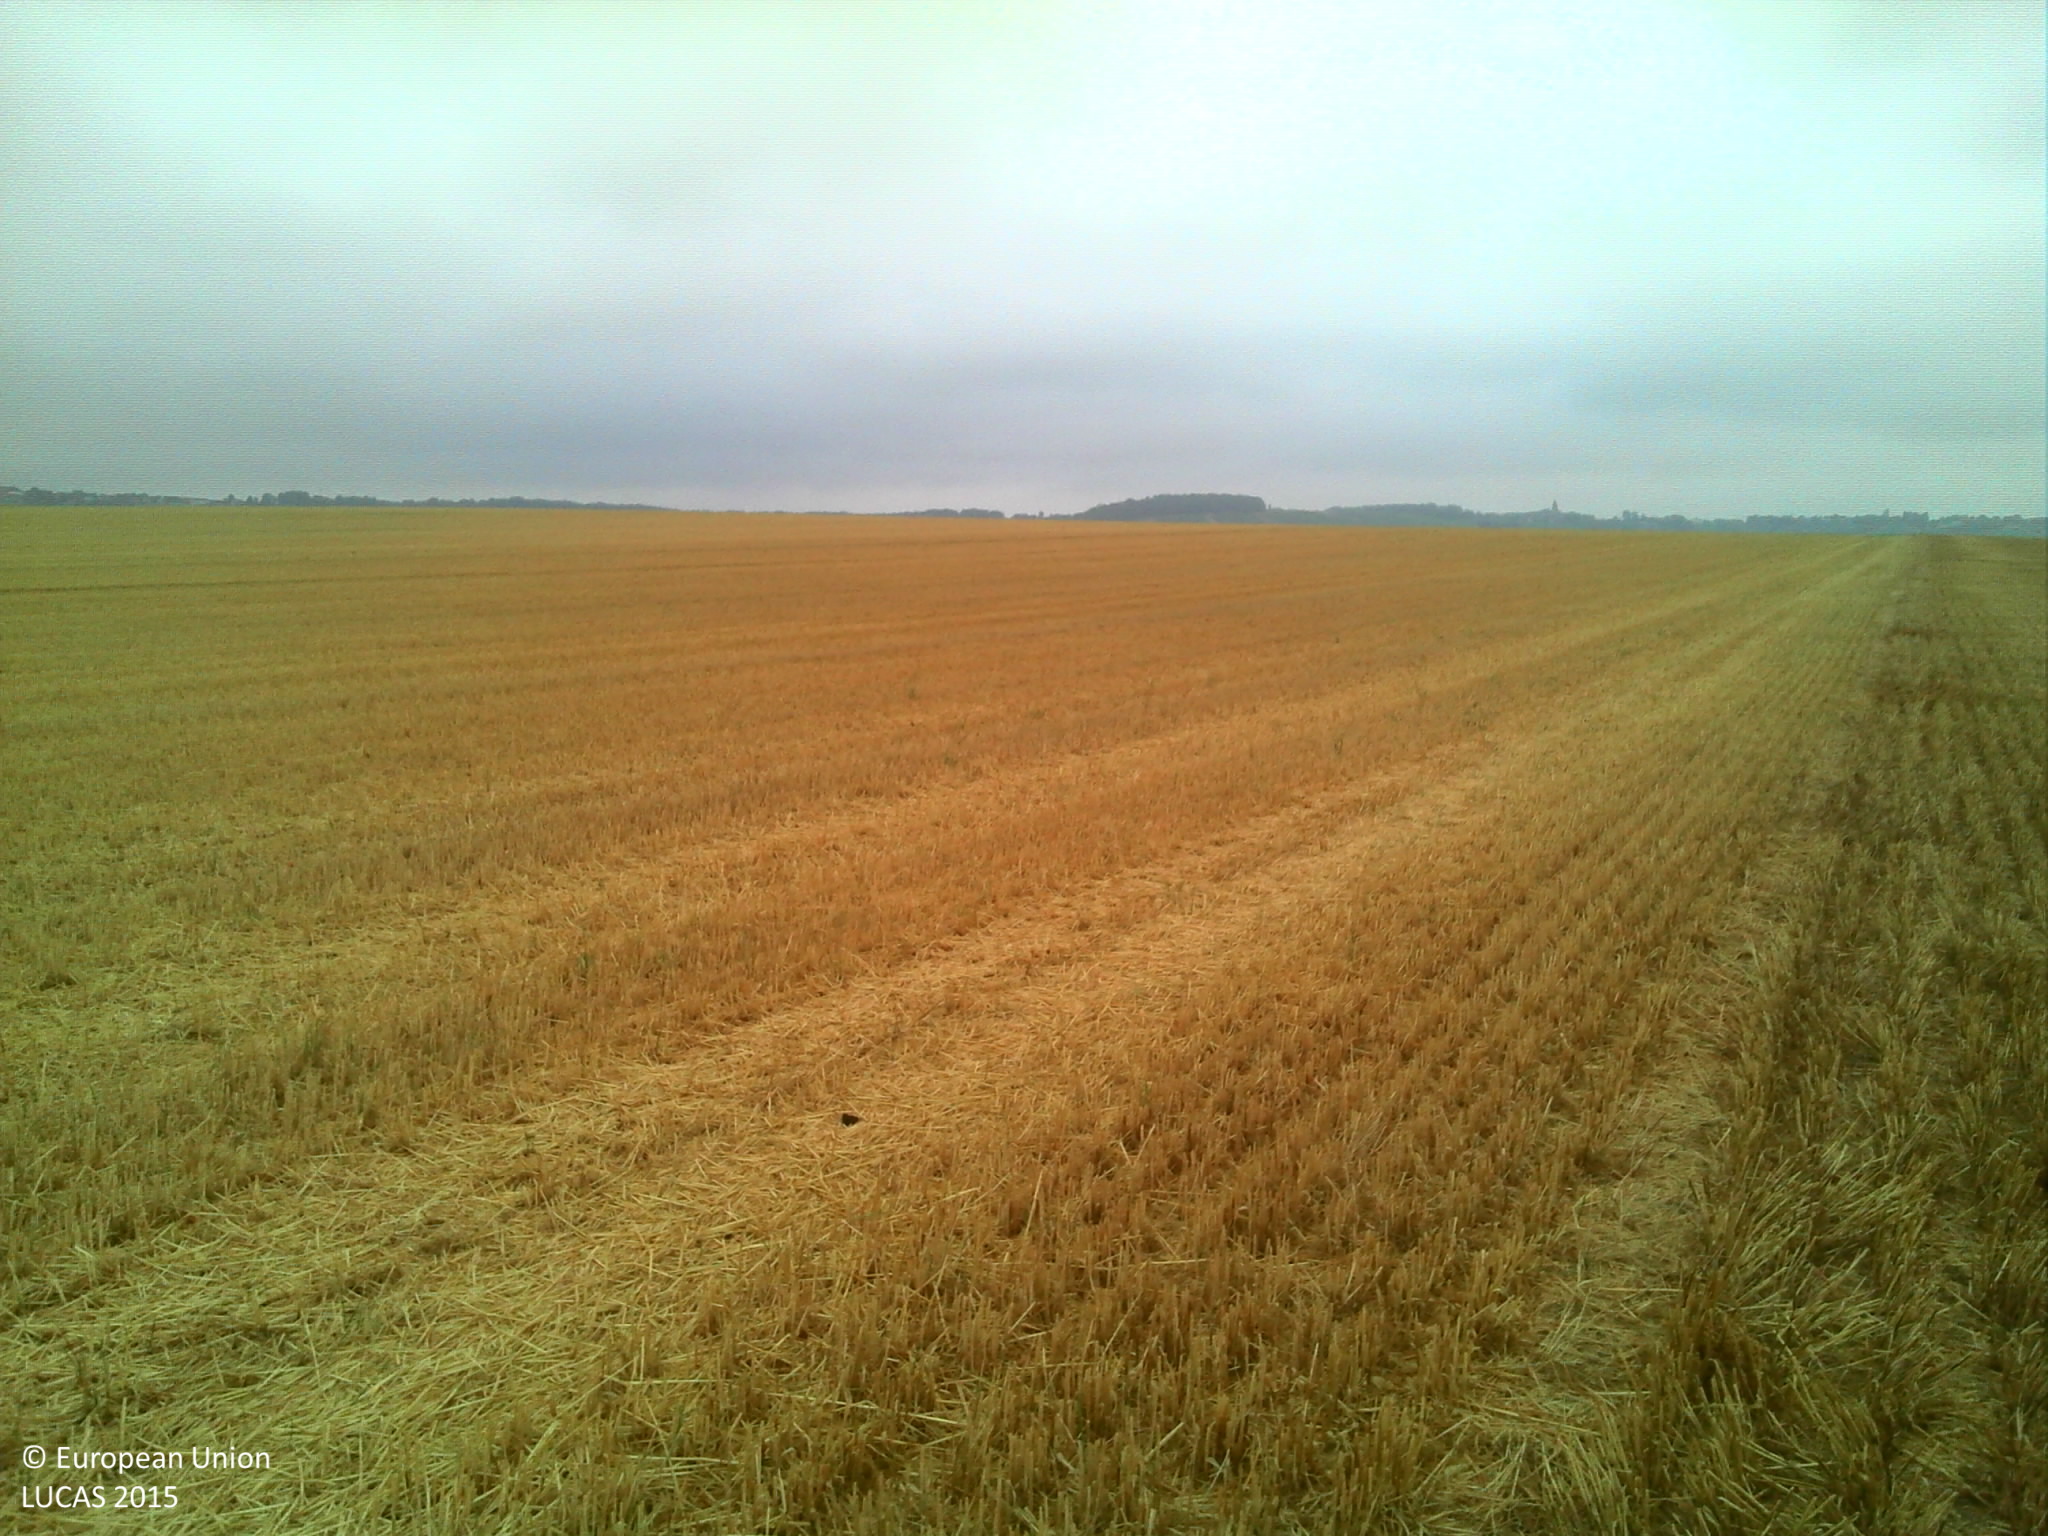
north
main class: Cropland
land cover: Common wheat
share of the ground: > 75 %
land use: Agriculture (excluding fallow land and kitchen gardens)
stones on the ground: < 10 %
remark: Harvested field
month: July
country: FR
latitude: 48.7337
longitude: 3.7811
